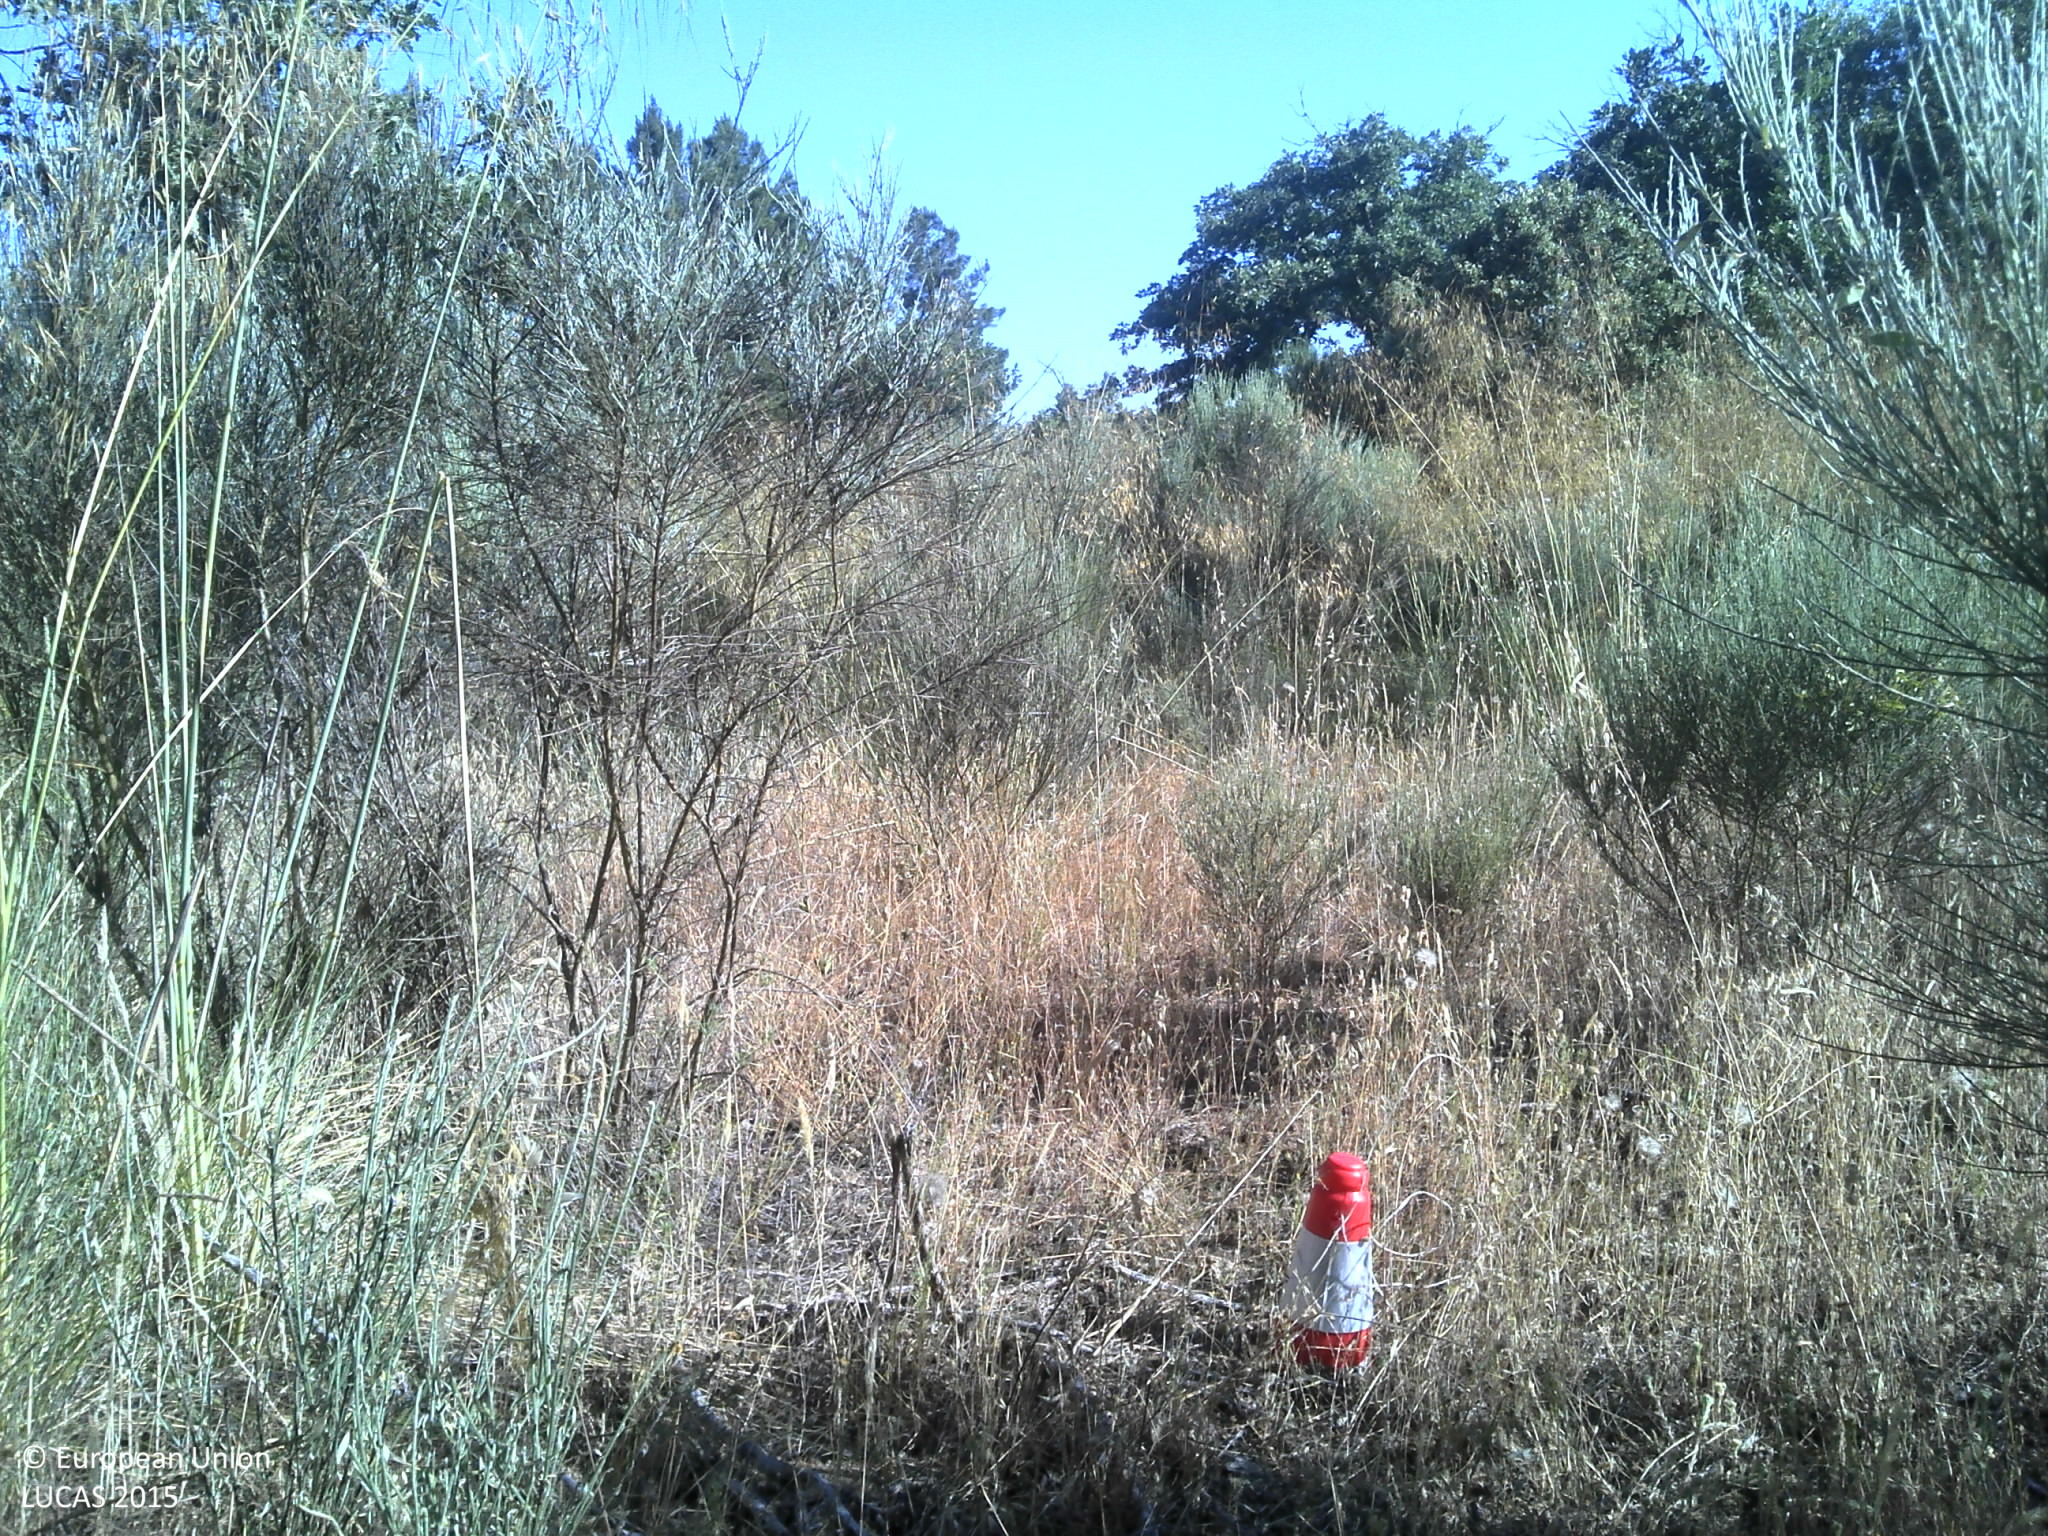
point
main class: Shrubland
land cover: Shrubland with sparse tree cover
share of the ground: 50 - 75 %
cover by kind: shrubs 65 %, herbaceous plants 15 %, unconsolidated bare surface 15 %, broadleaved forest trees 5 %
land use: Agriculture (excluding fallow land and kitchen gardens)
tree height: > 5 m
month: June
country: PT
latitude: 40.6661
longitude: -6.8115
